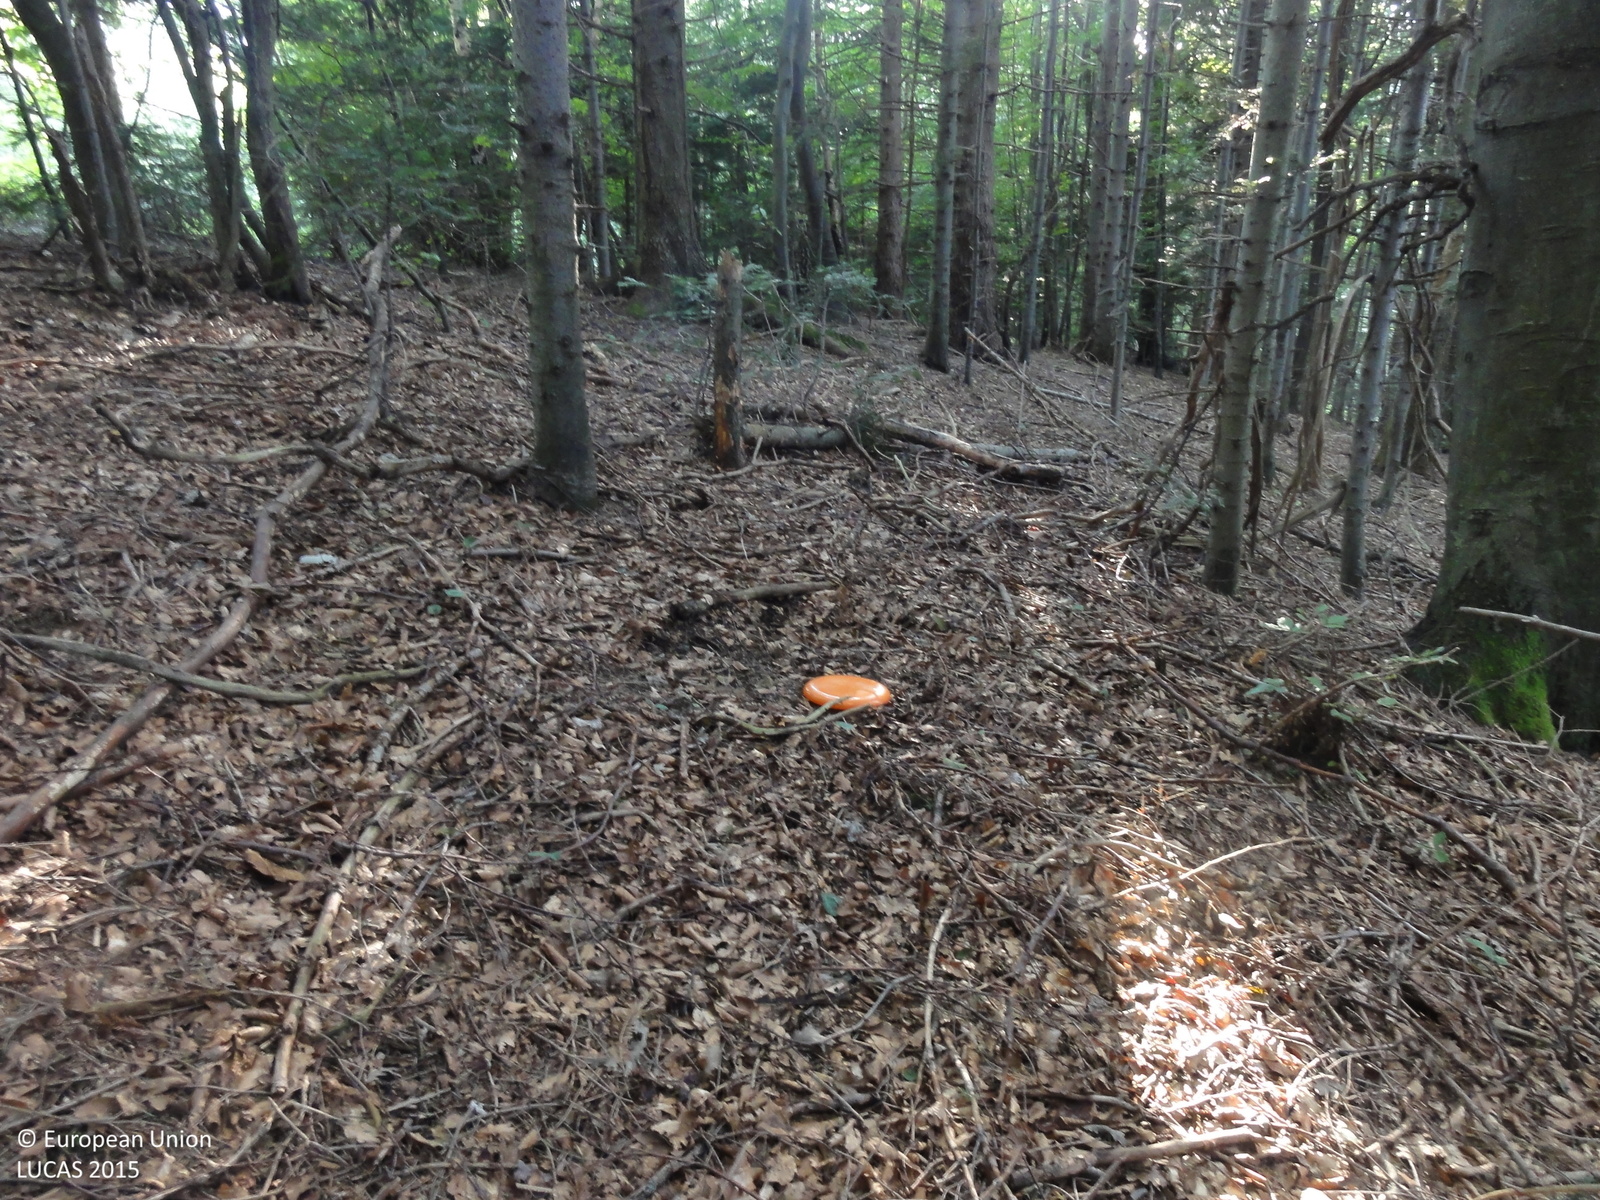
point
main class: Woodland
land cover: Spruce dominated mixed woodland
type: mountainous beech forest
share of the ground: > 75 %
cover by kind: coniferous forest trees 70 %, broadleaved forest trees 30 %
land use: Forestry
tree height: > 5 m
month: August
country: SI
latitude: 46.0657
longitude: 15.4919
